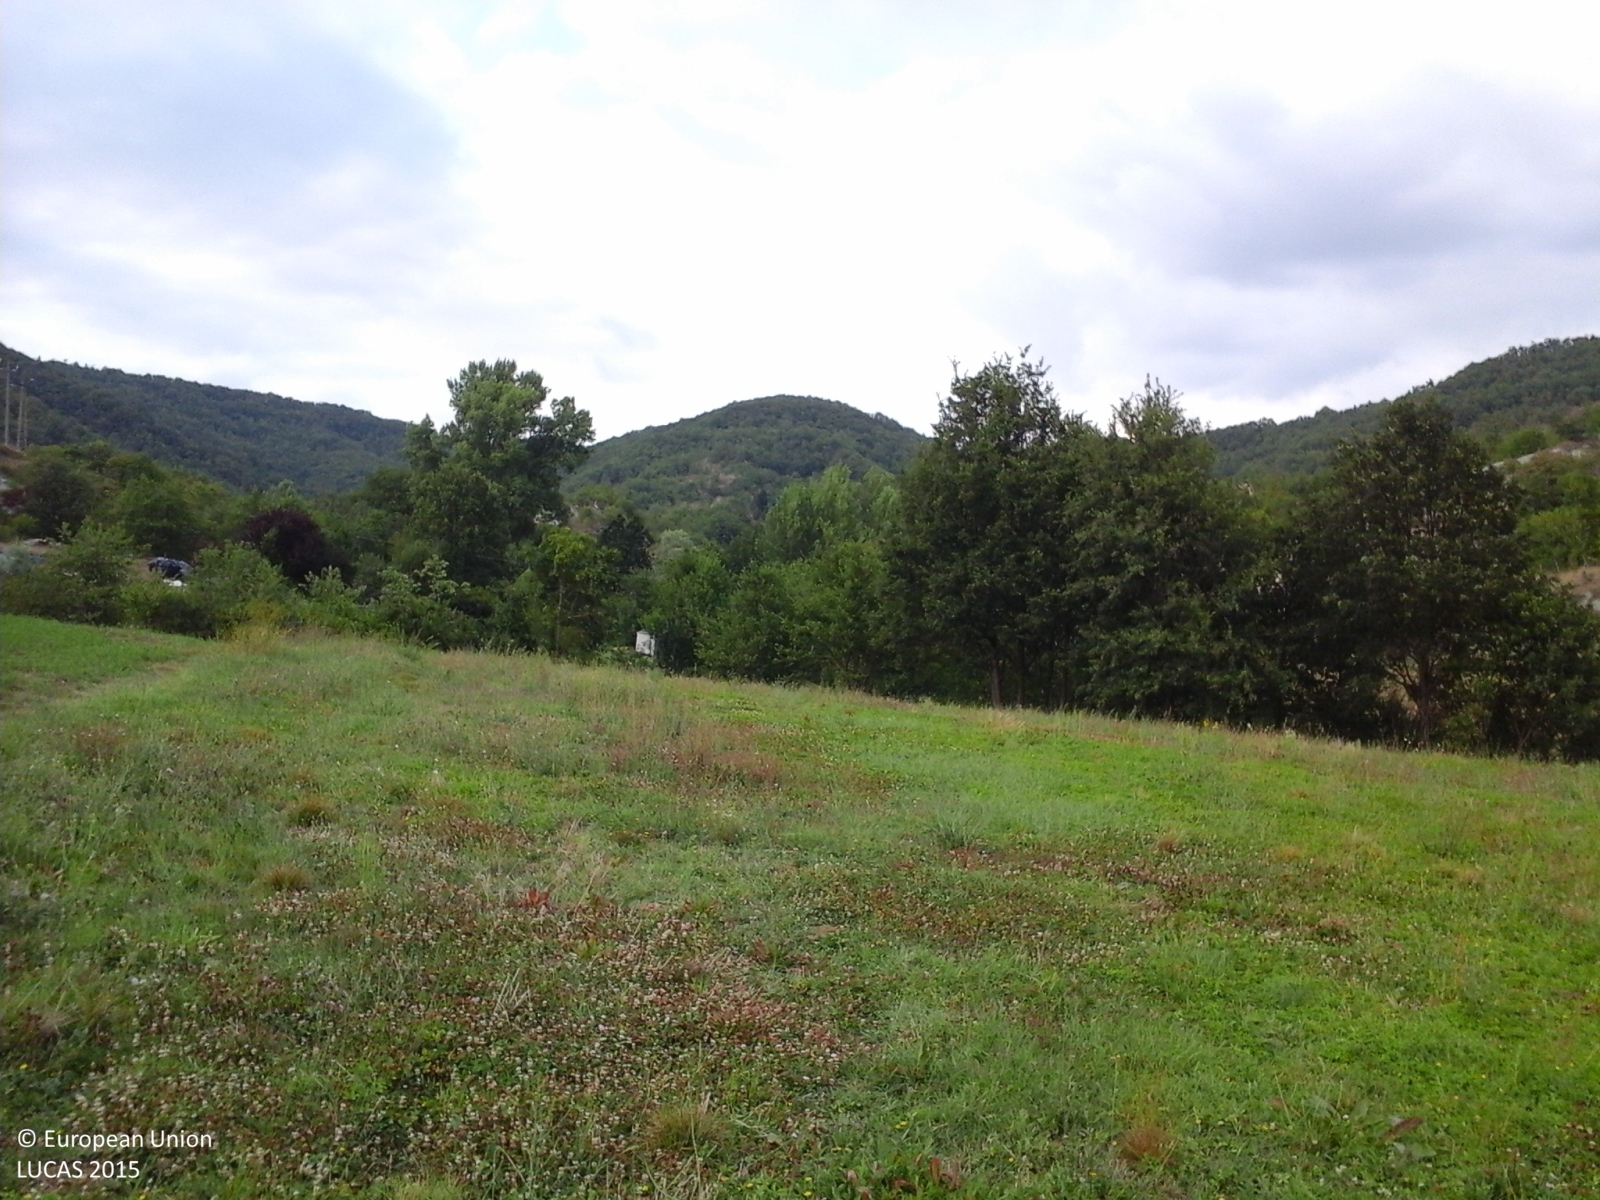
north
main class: Cropland
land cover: Lucerne
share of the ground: > 75 %
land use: Agriculture (excluding fallow land and kitchen gardens)
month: July
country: IT
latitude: 44.4261
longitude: 8.2578
